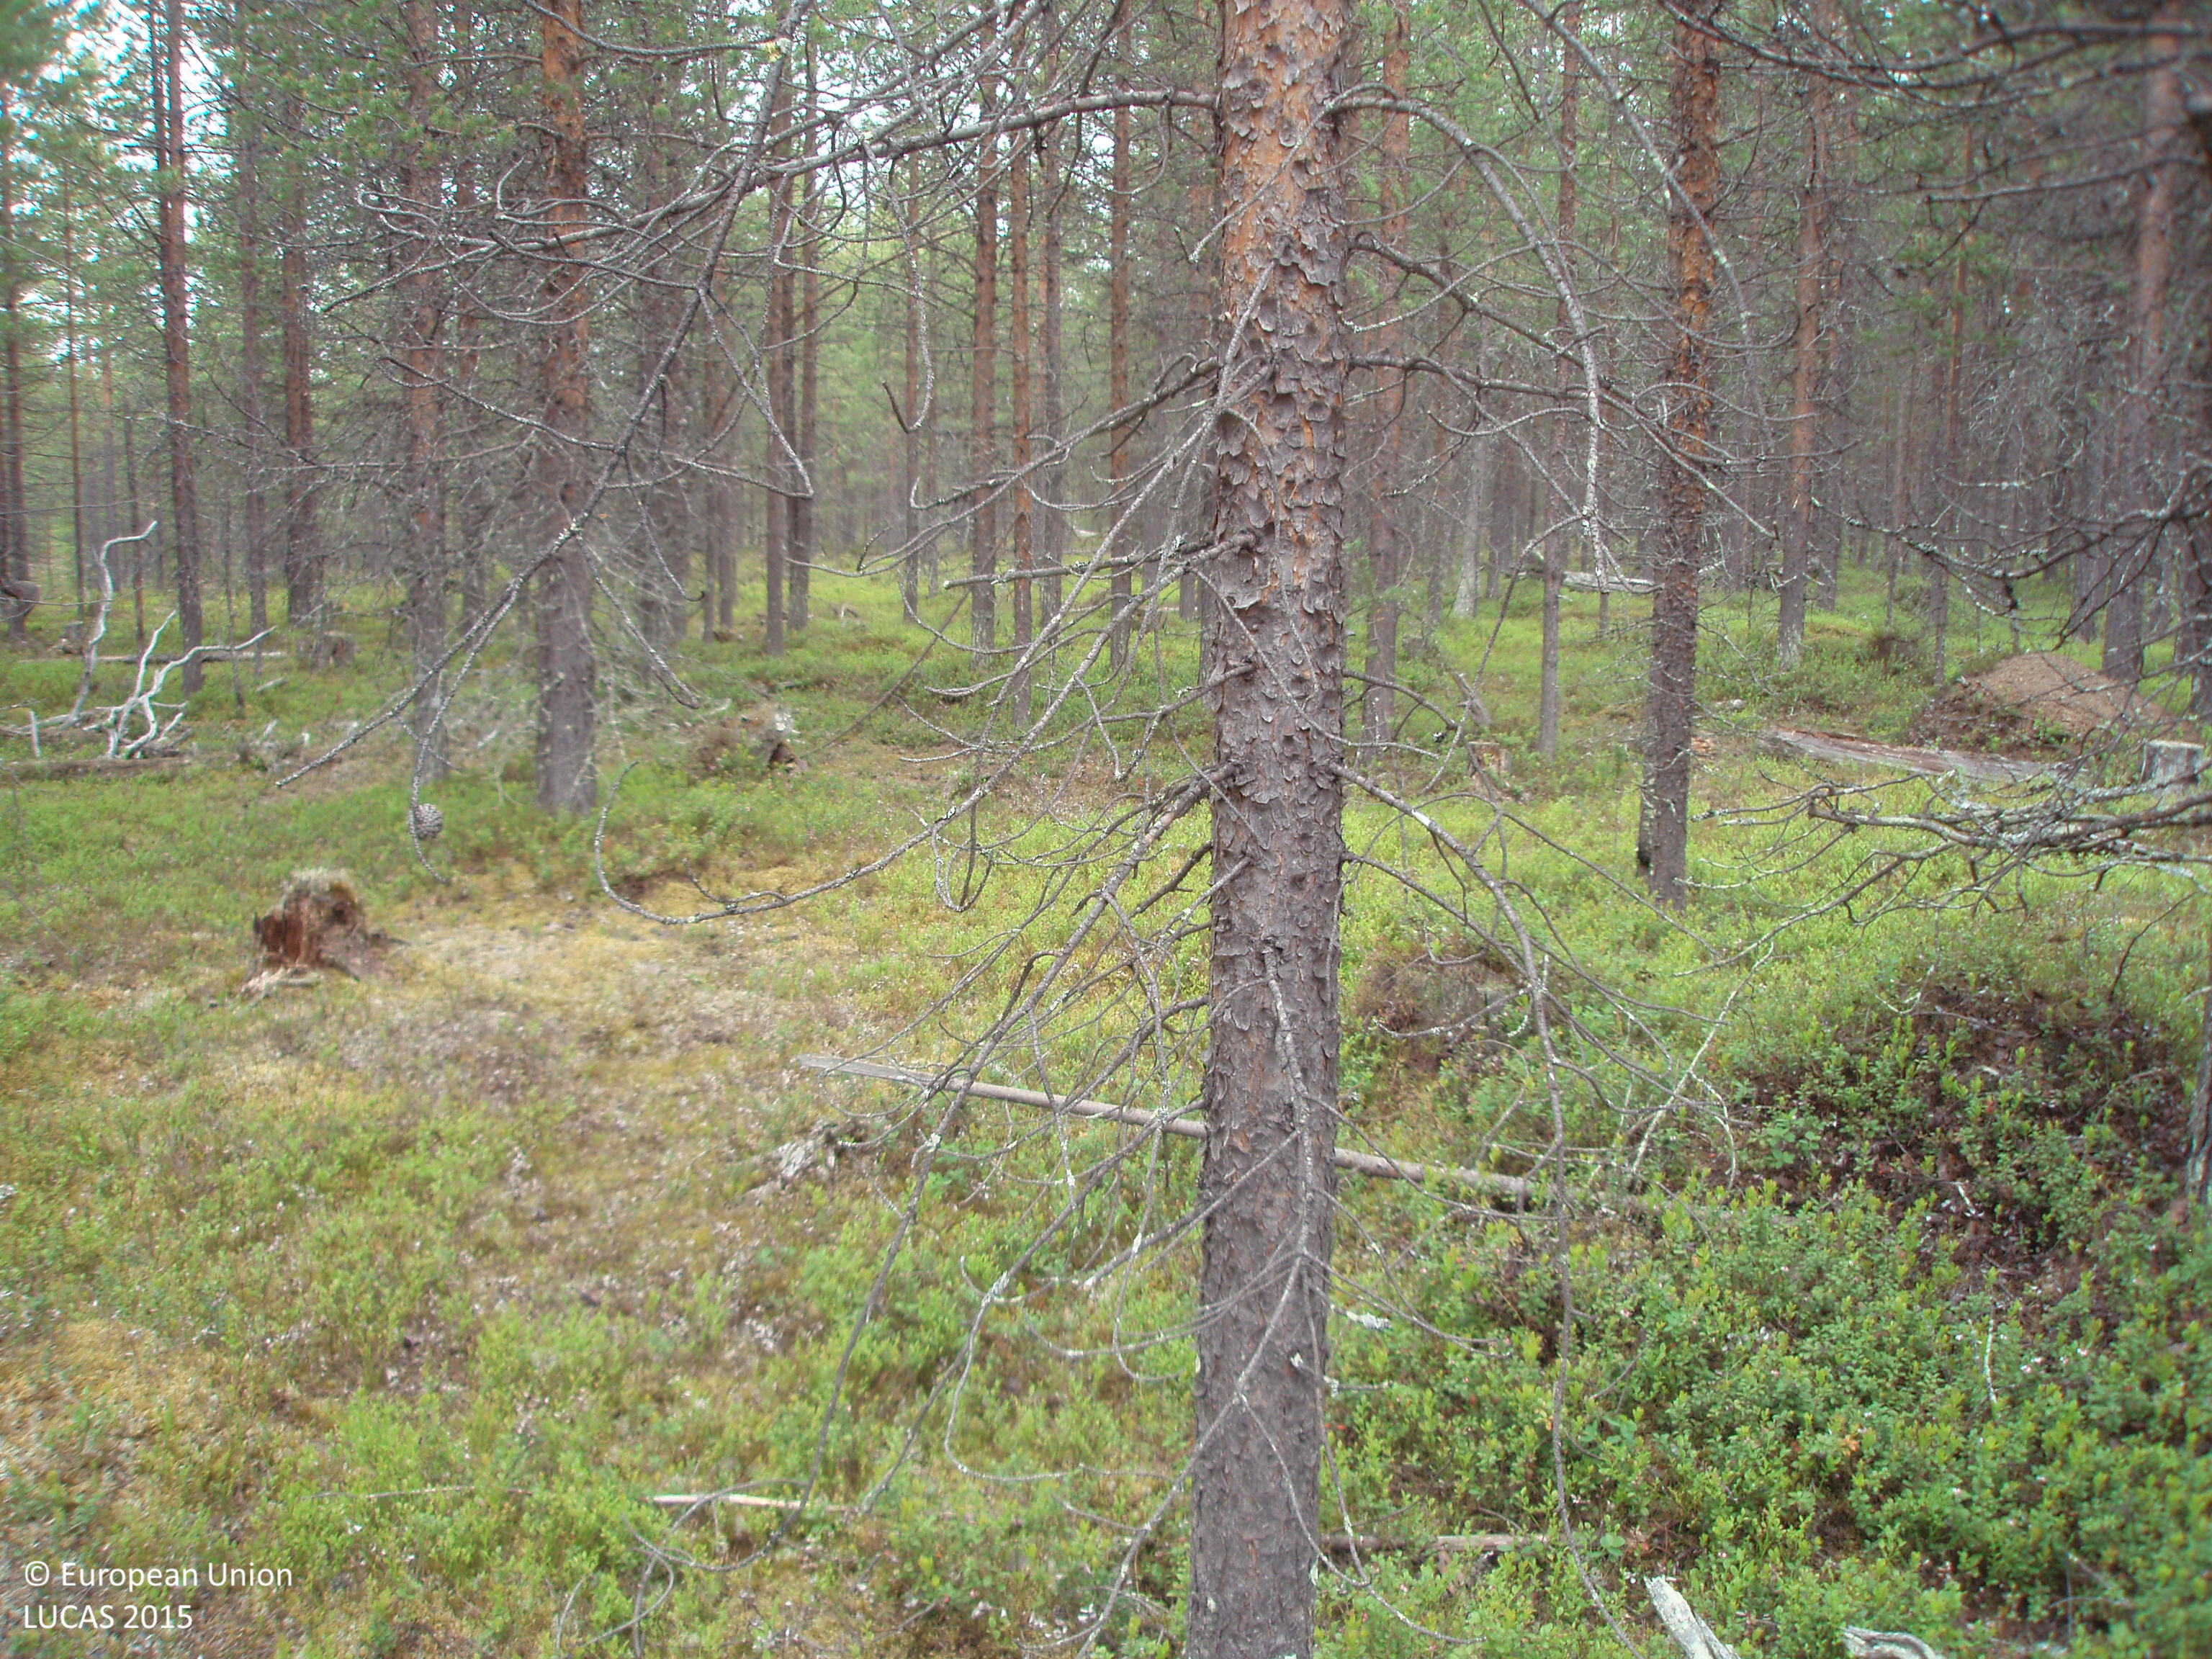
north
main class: Woodland
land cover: Pine dominated coniferous woodland
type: boreal forest
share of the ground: > 75 %
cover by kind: coniferous forest trees 75 %, shrubs 25 %
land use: Forestry
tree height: > 5 m
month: July
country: FI
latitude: 67.7353
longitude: 28.9906
